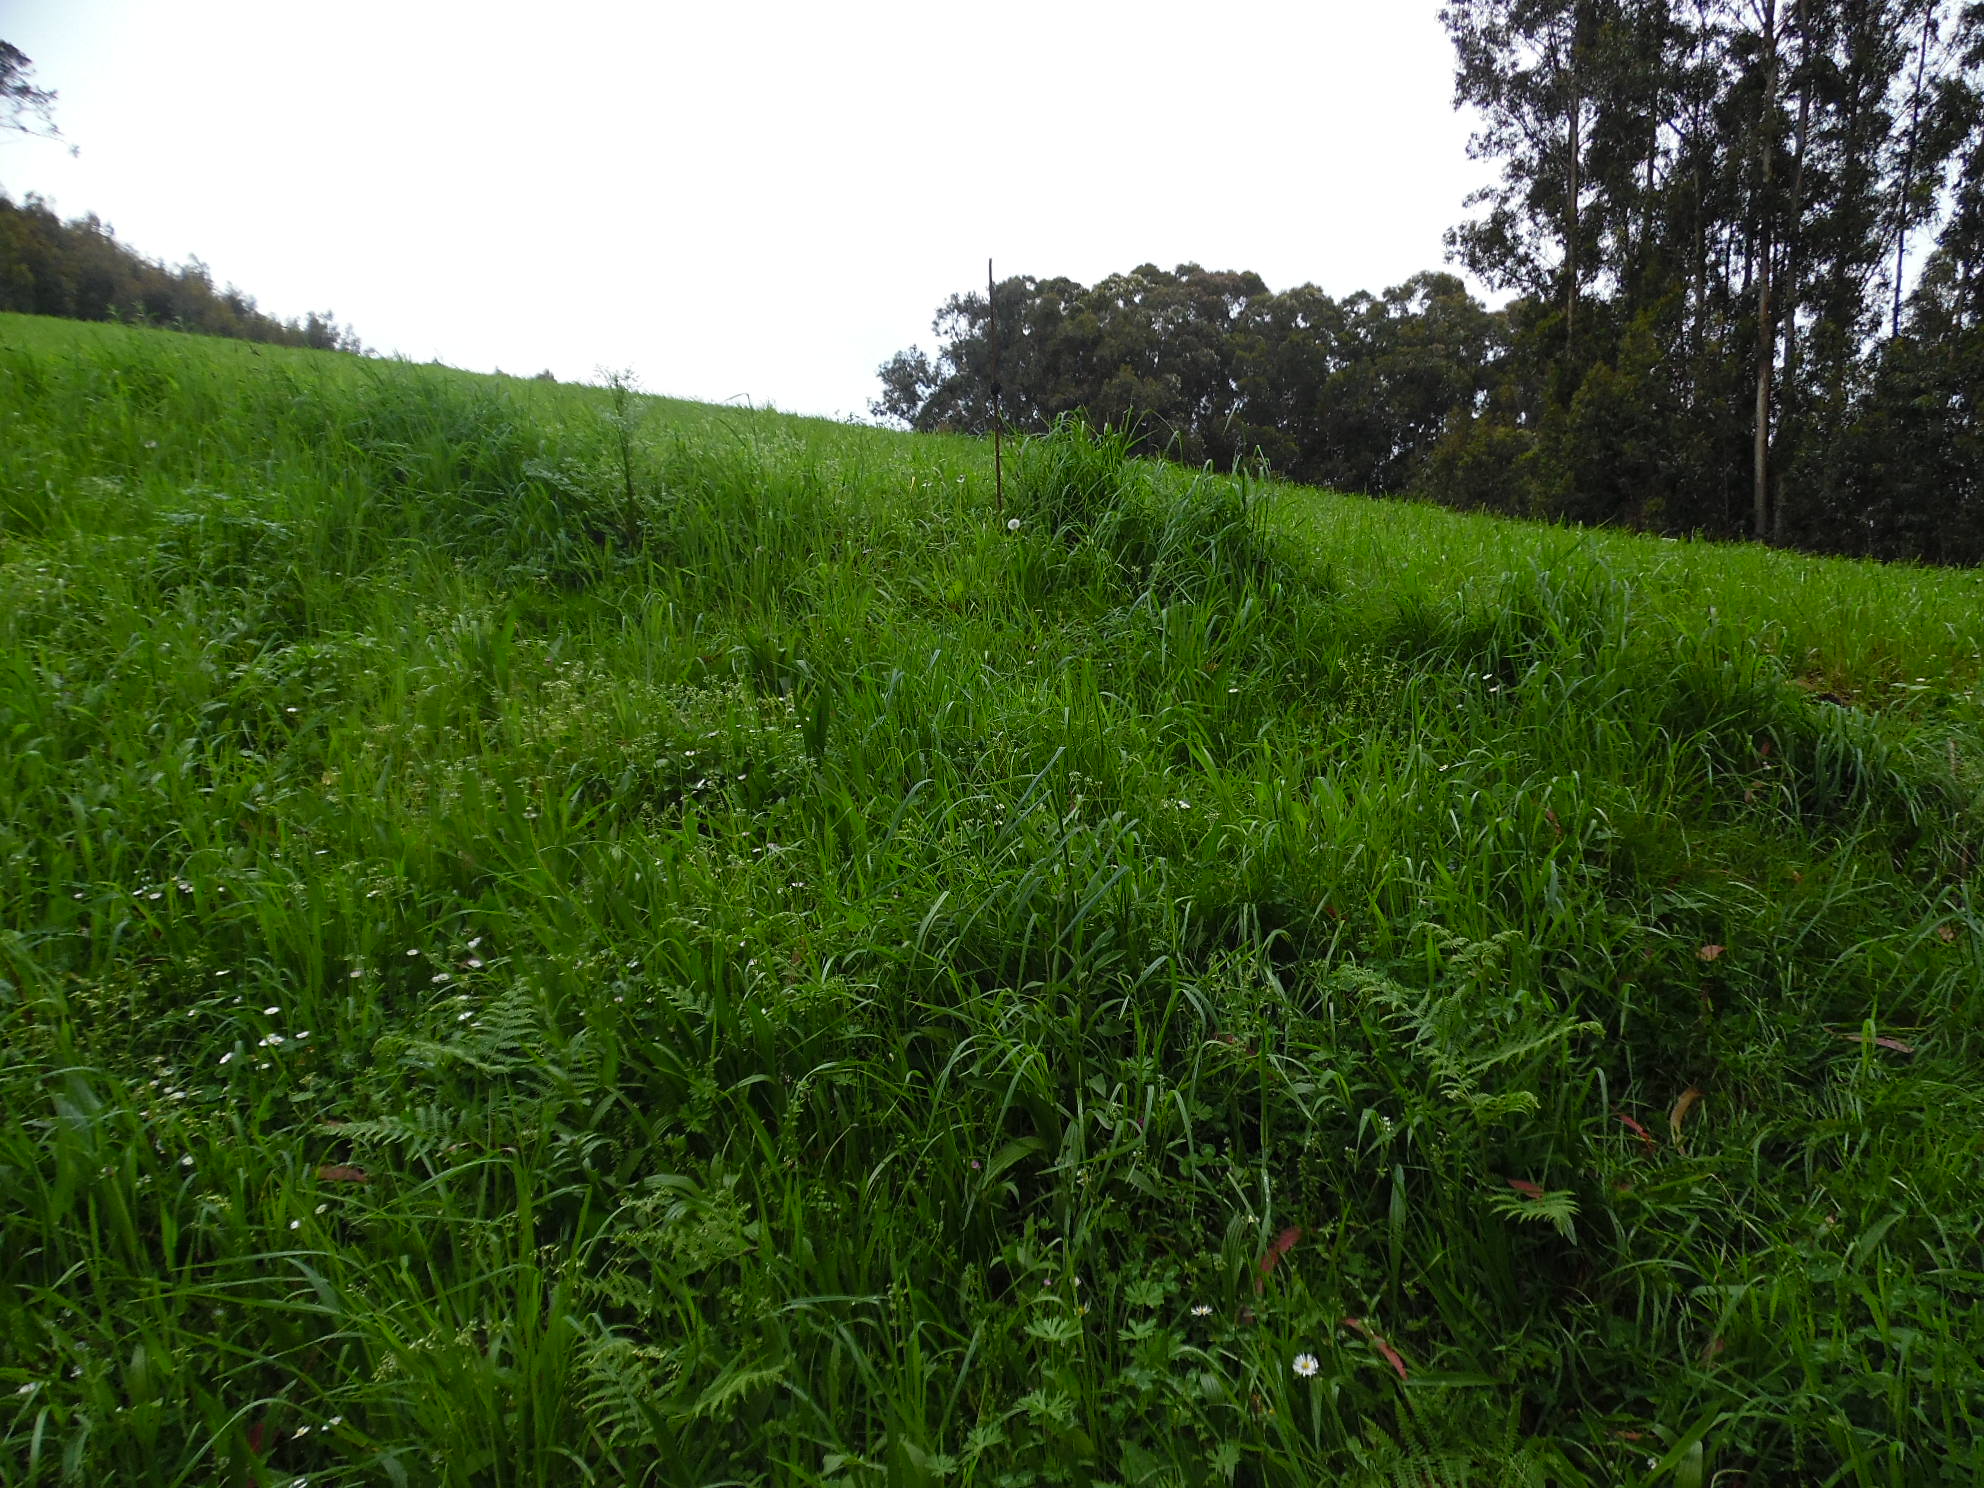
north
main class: Grassland
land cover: Grassland without tree/shrub cover
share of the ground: > 75 %
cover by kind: herbaceous plants 100 %
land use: Agriculture (excluding fallow land and kitchen gardens)
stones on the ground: 10 - 25 %
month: April
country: ES
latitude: 43.5031
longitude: -5.8842
